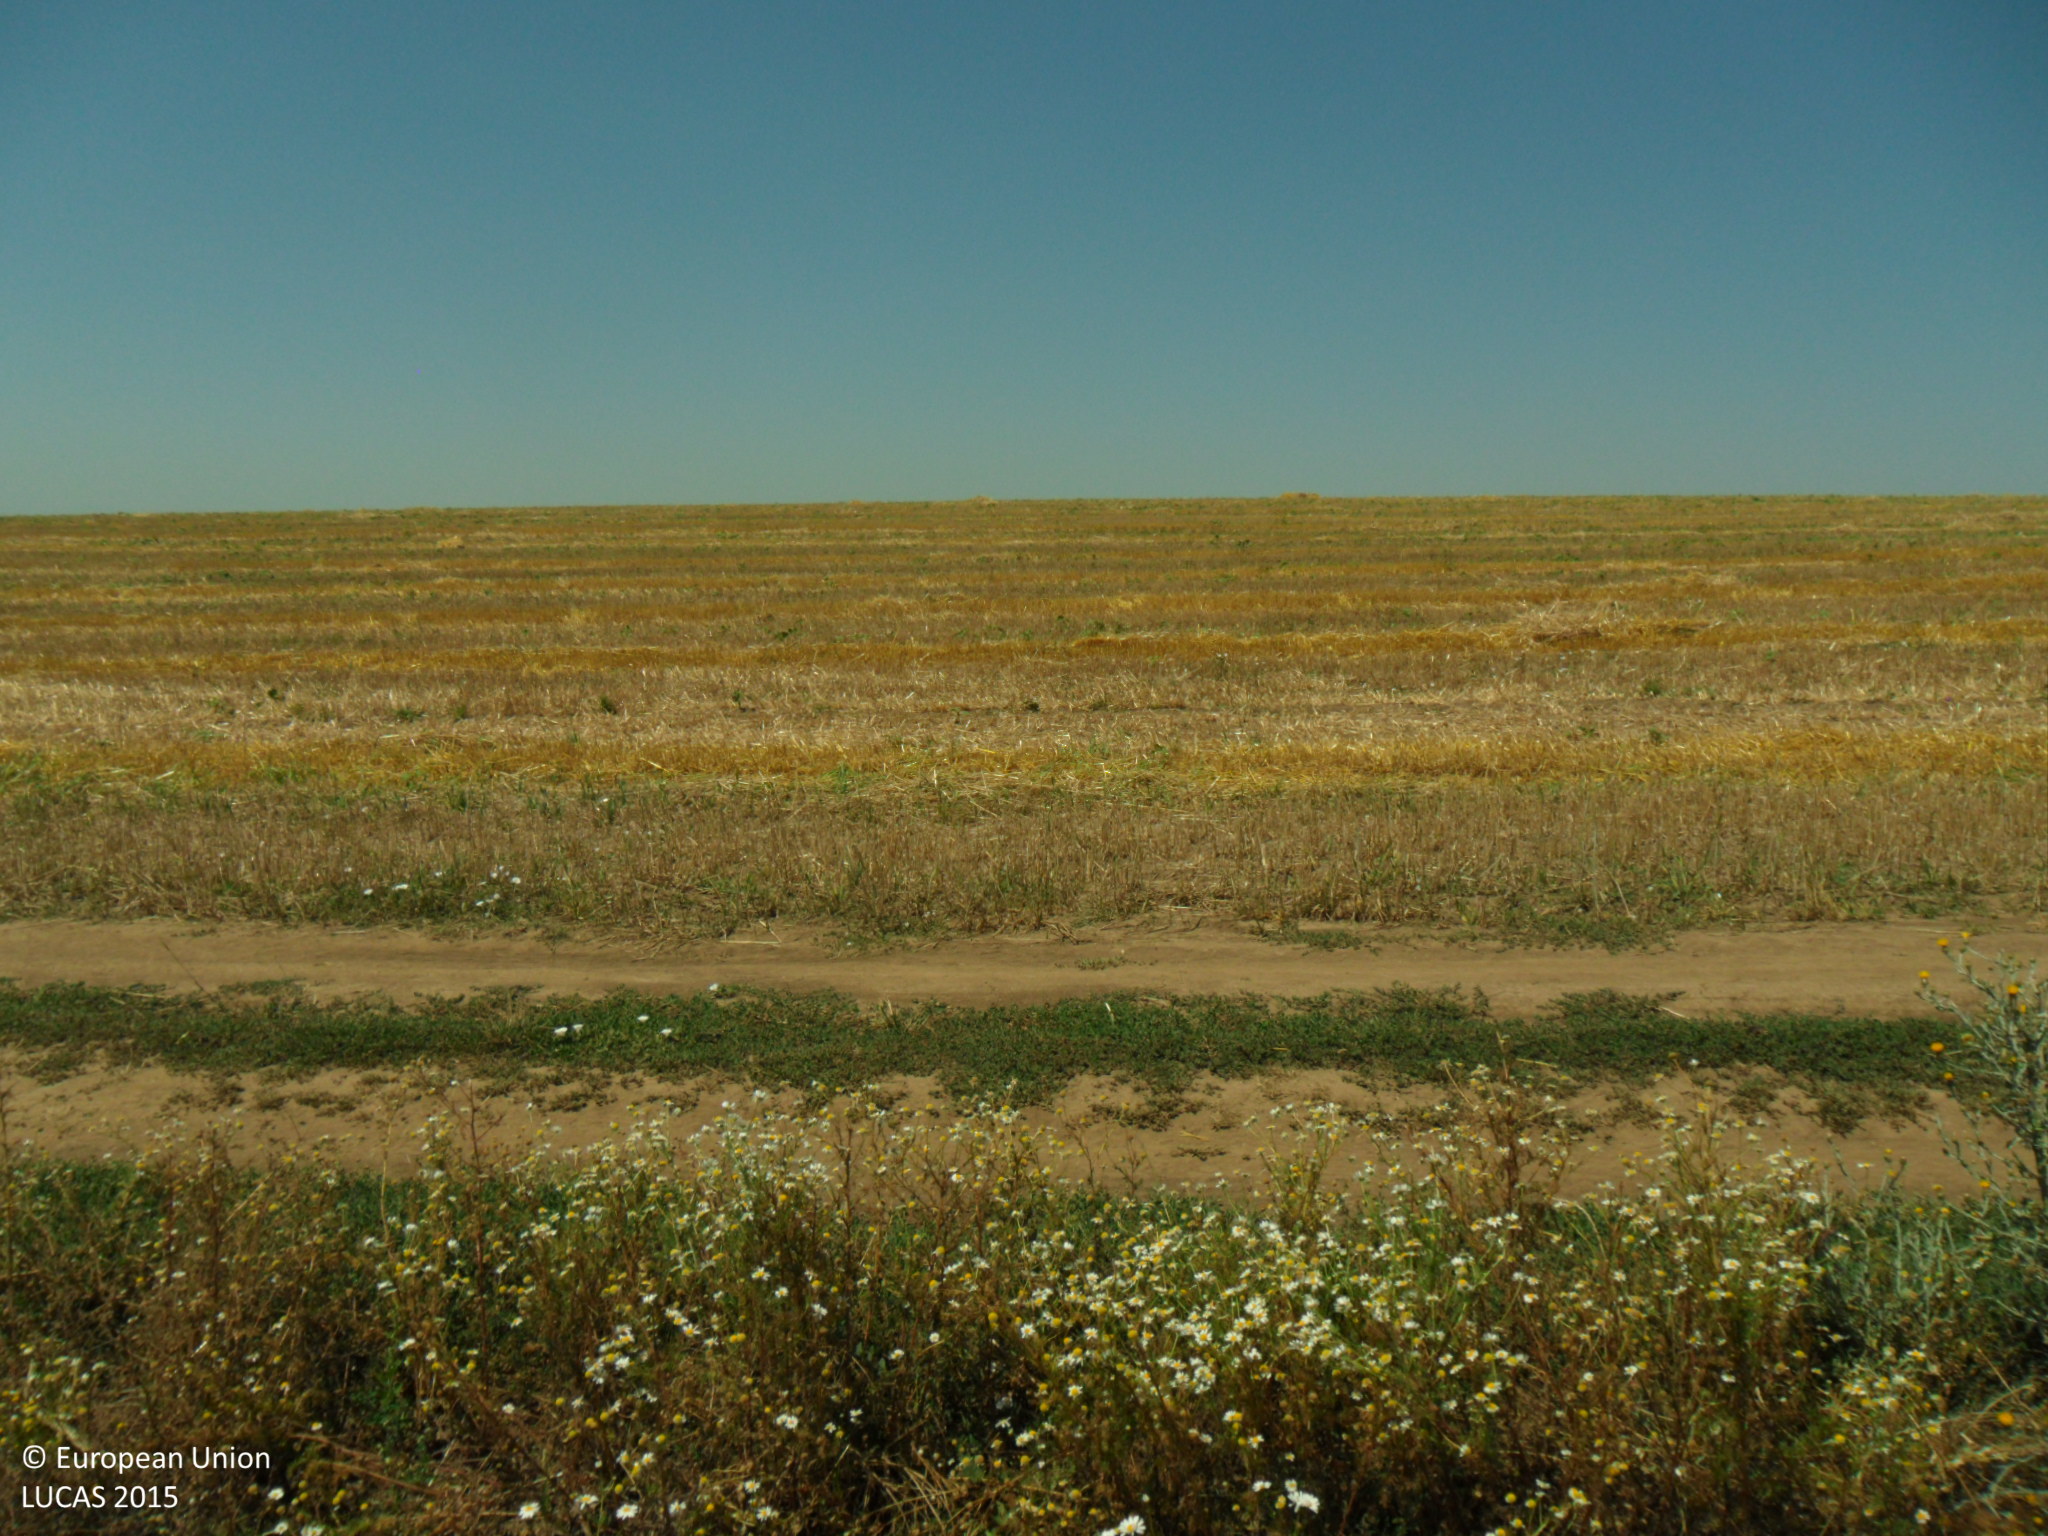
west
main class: Cropland
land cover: Common wheat
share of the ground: > 75 %
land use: Agriculture (excluding fallow land and kitchen gardens)
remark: Harvested field
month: July
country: BG
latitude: 43.7889
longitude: 26.3970
